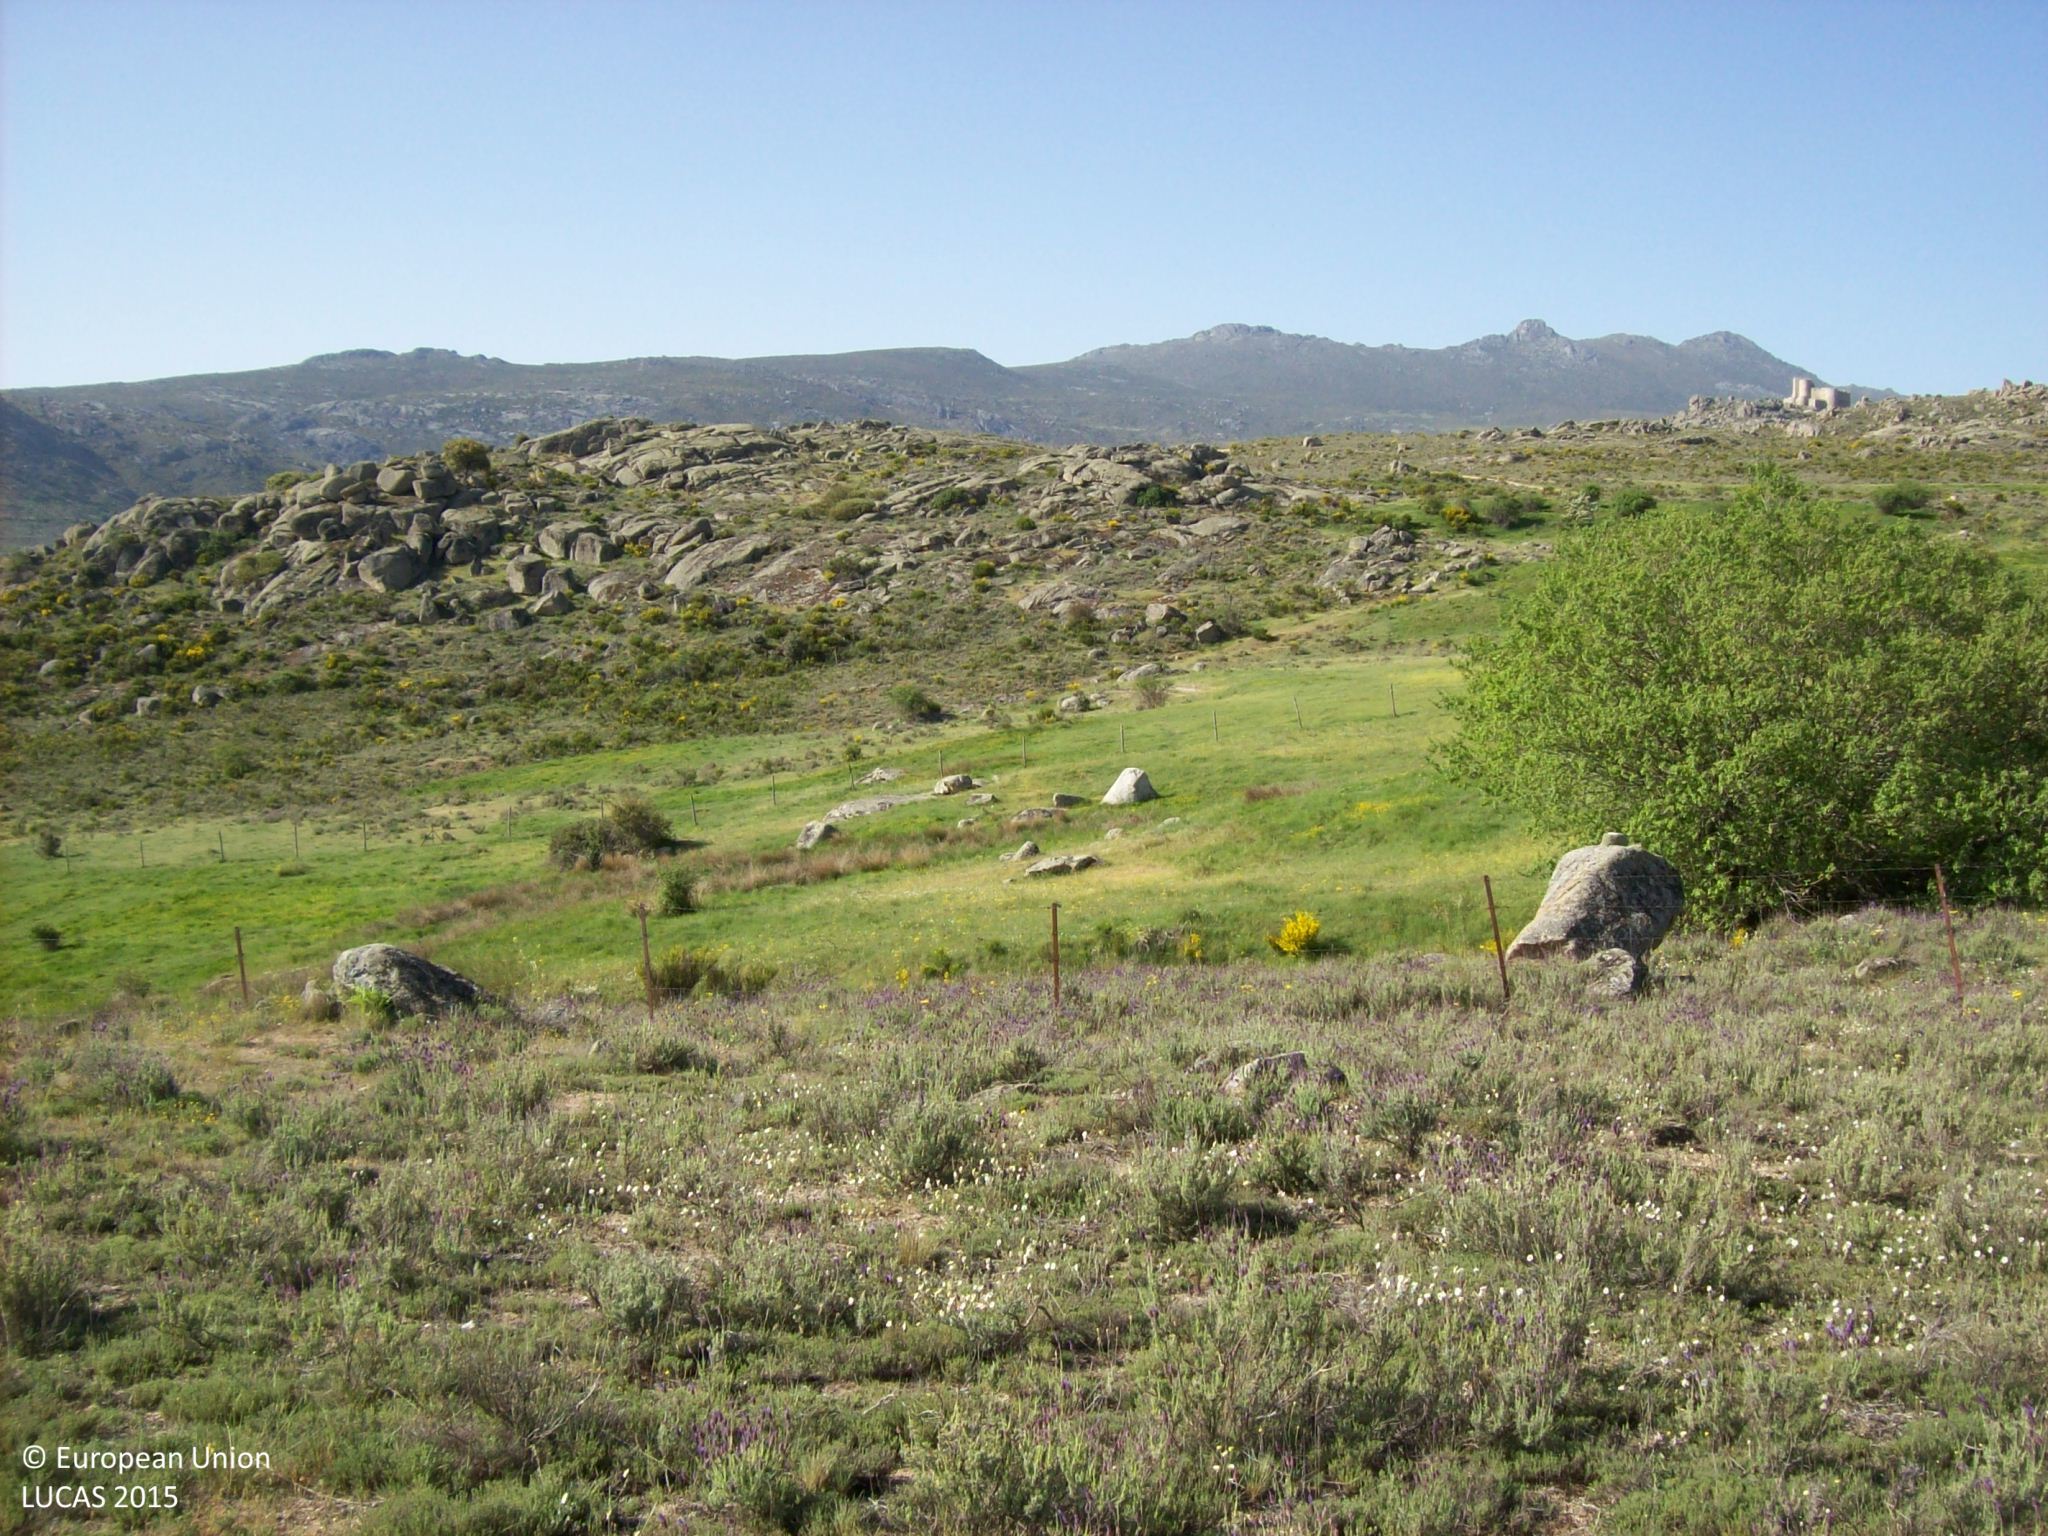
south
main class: Shrubland
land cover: Shrubland without tree cover
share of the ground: 50 - 75 %
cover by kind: shrubs 60 %, herbaceous plants 20 %, consolidated bare surface 5 %, unconsolidated bare surface 5 %
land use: Semi-natural and natural areas not in use
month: May
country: ES
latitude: 40.5470
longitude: -4.8280
